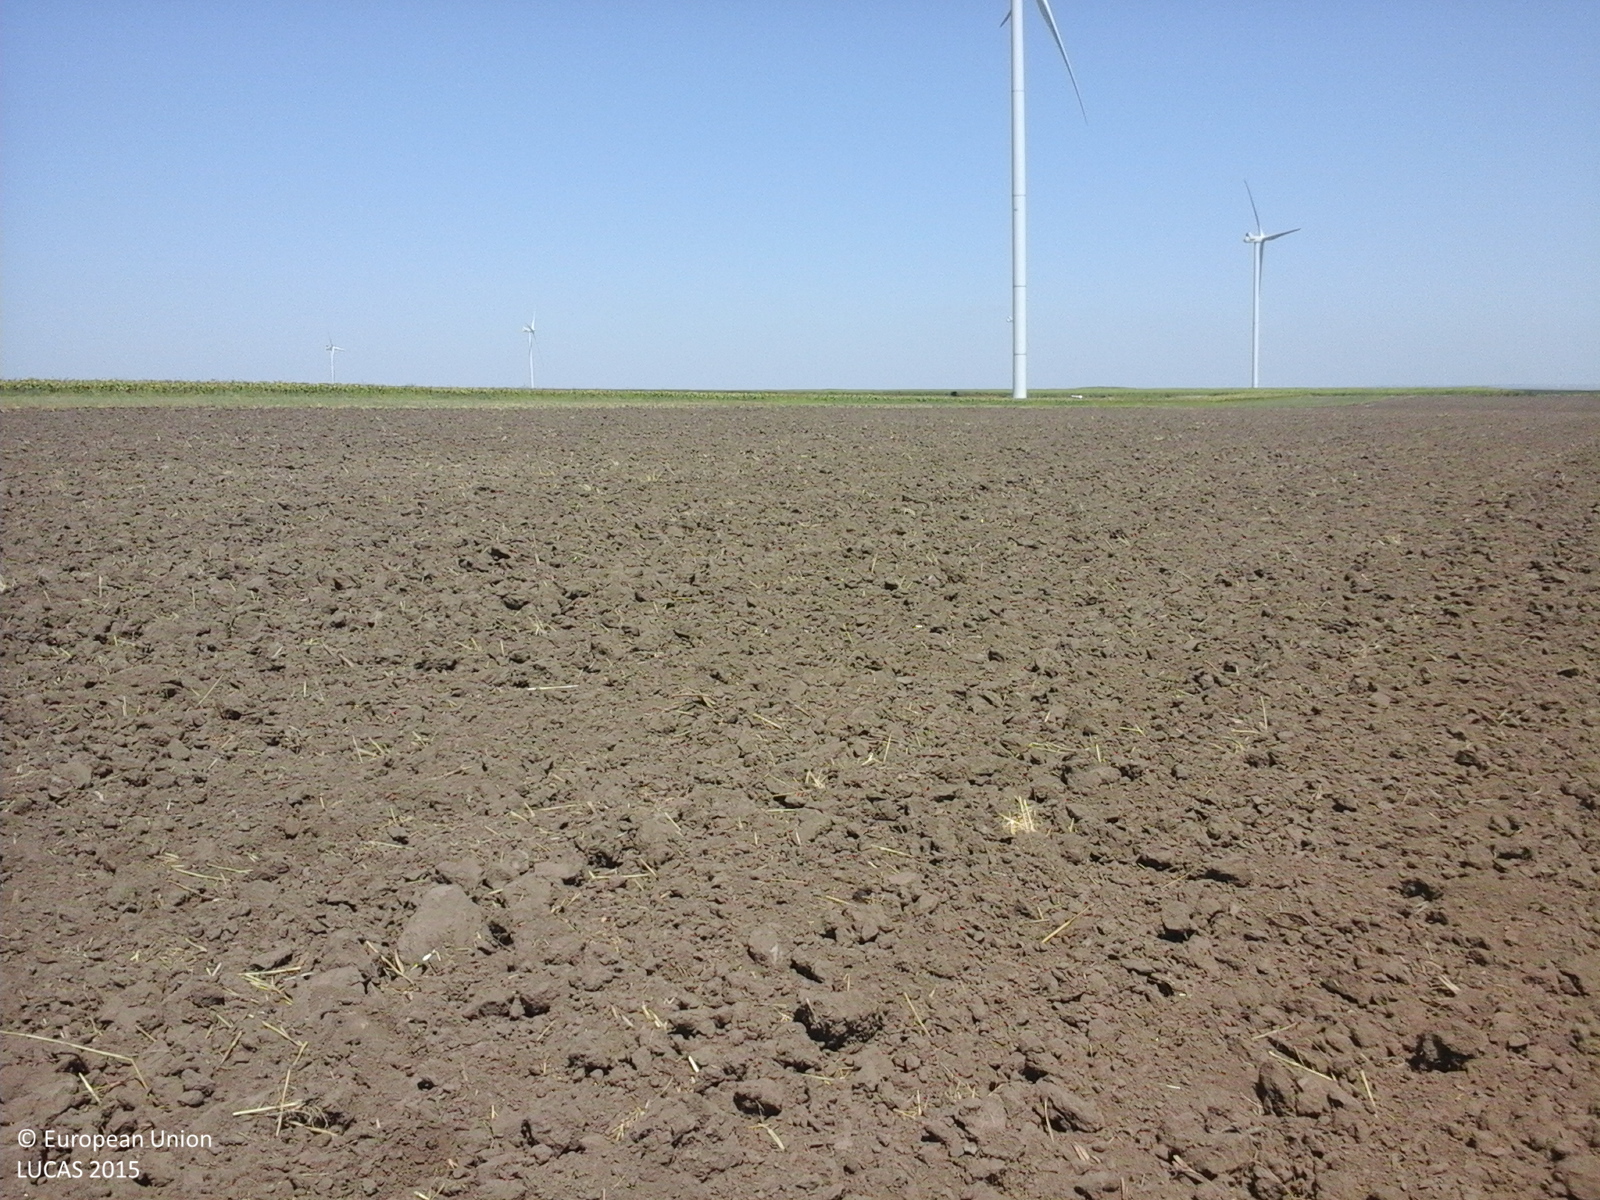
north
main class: Cropland
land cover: Barley
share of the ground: < 10 %
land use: Agriculture (excluding fallow land and kitchen gardens)
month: August
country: RO
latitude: 44.5941
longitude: 28.2697
